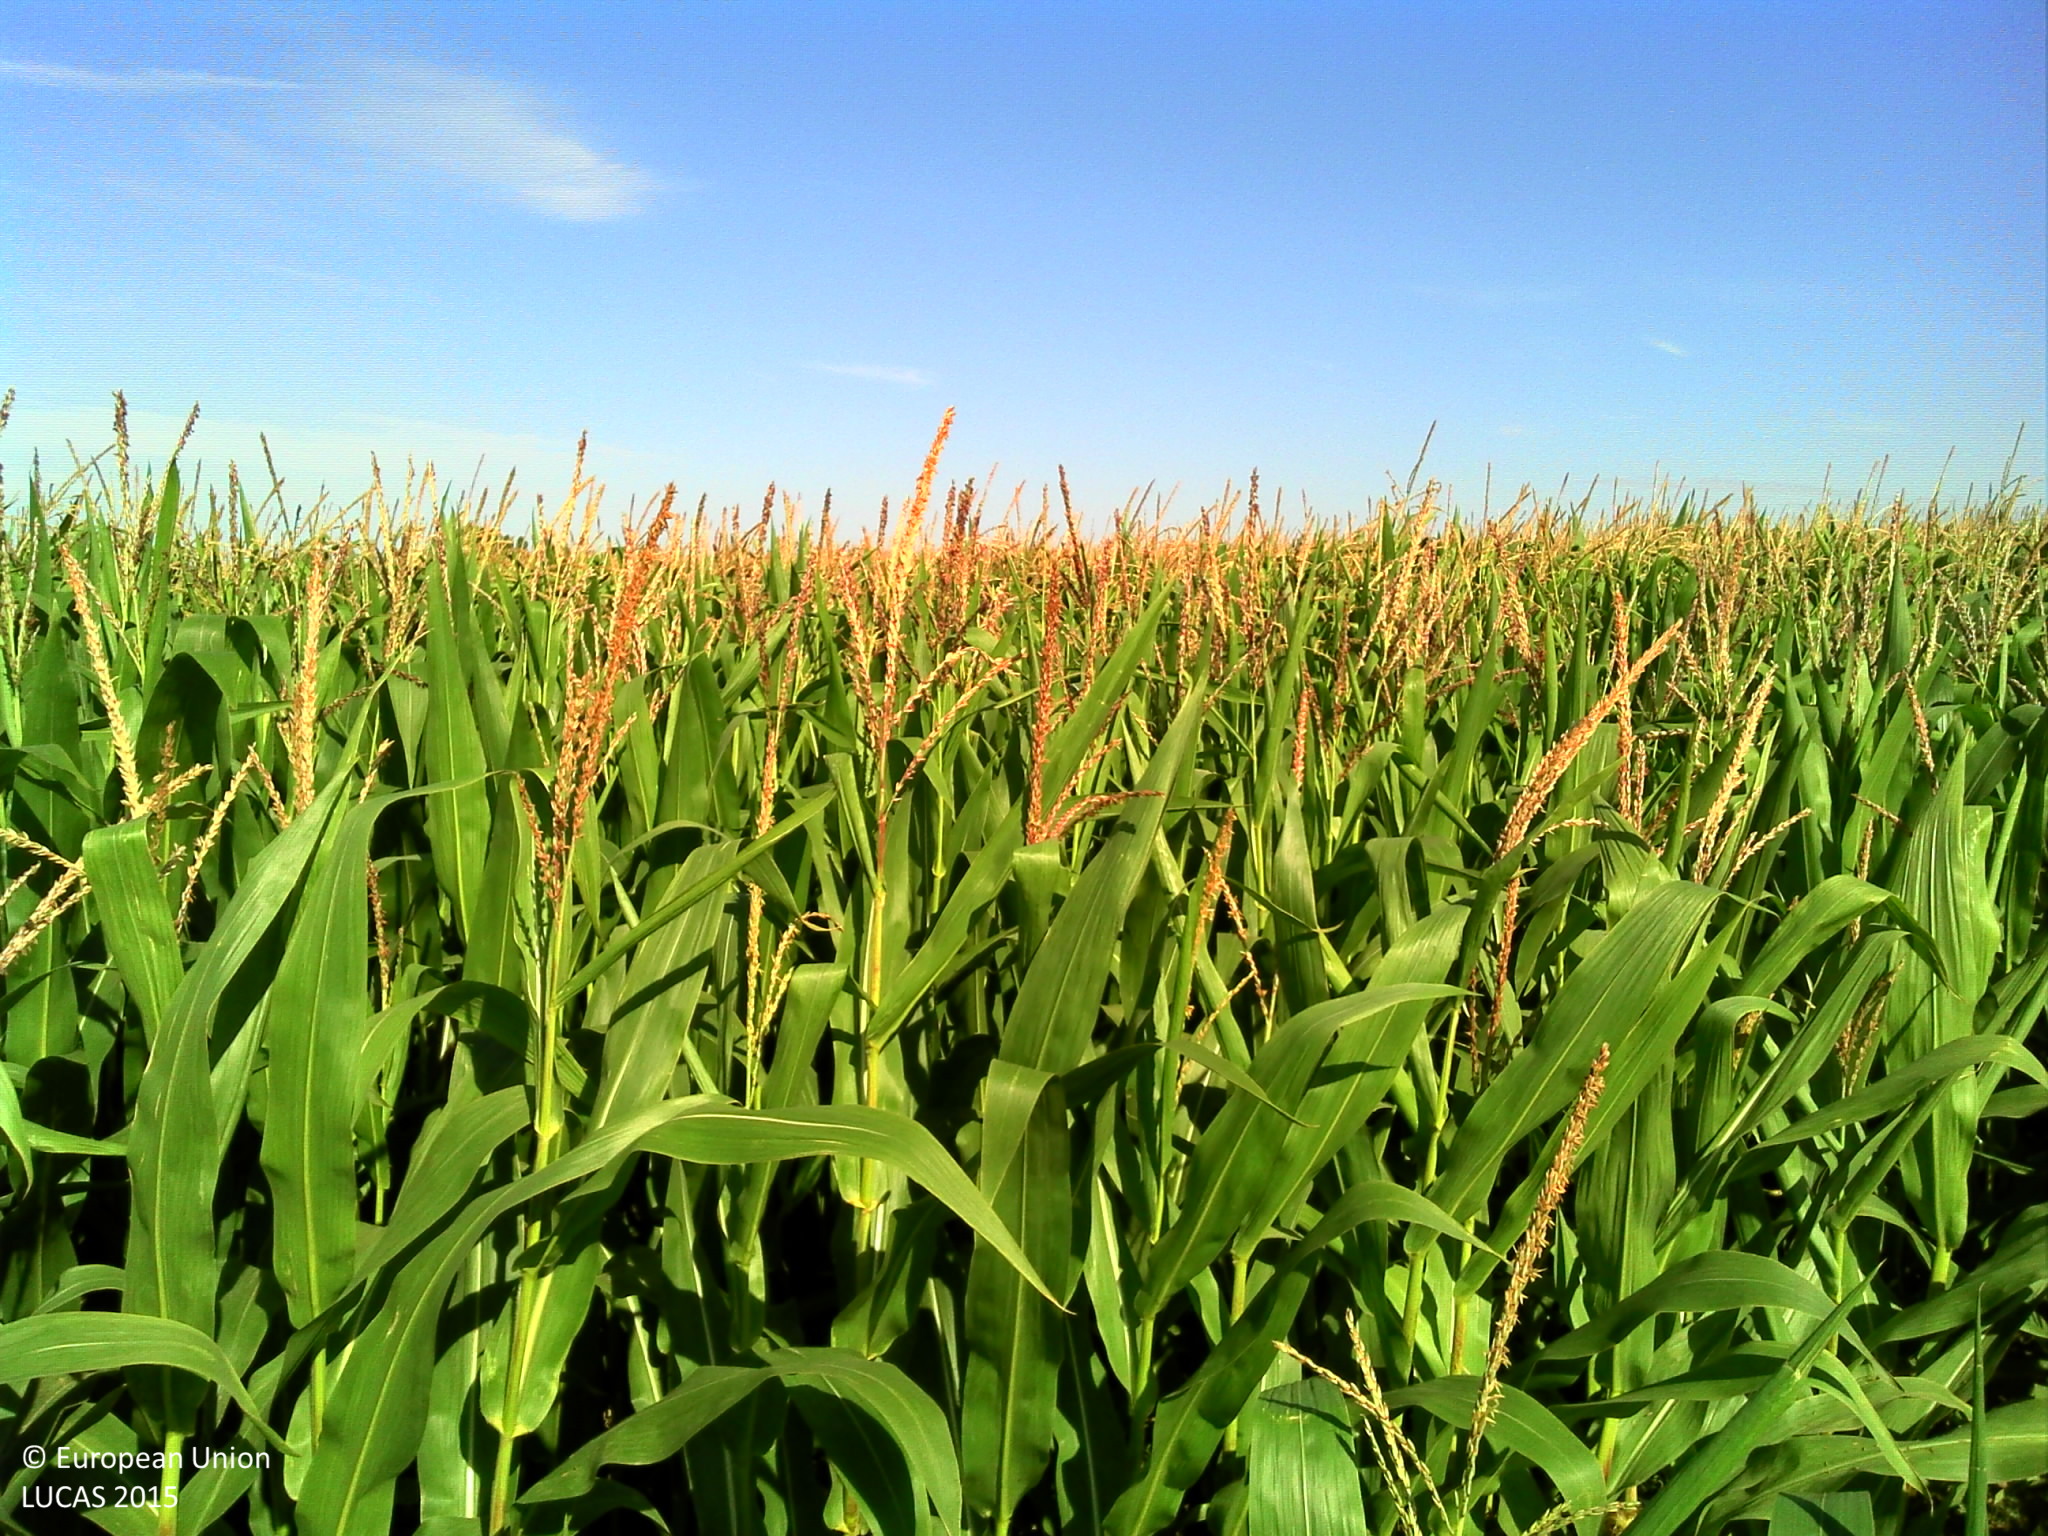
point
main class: Cropland
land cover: Maize
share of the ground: > 75 %
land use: Agriculture (excluding fallow land and kitchen gardens)
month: August
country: FR
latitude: 50.1684
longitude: 3.9601
